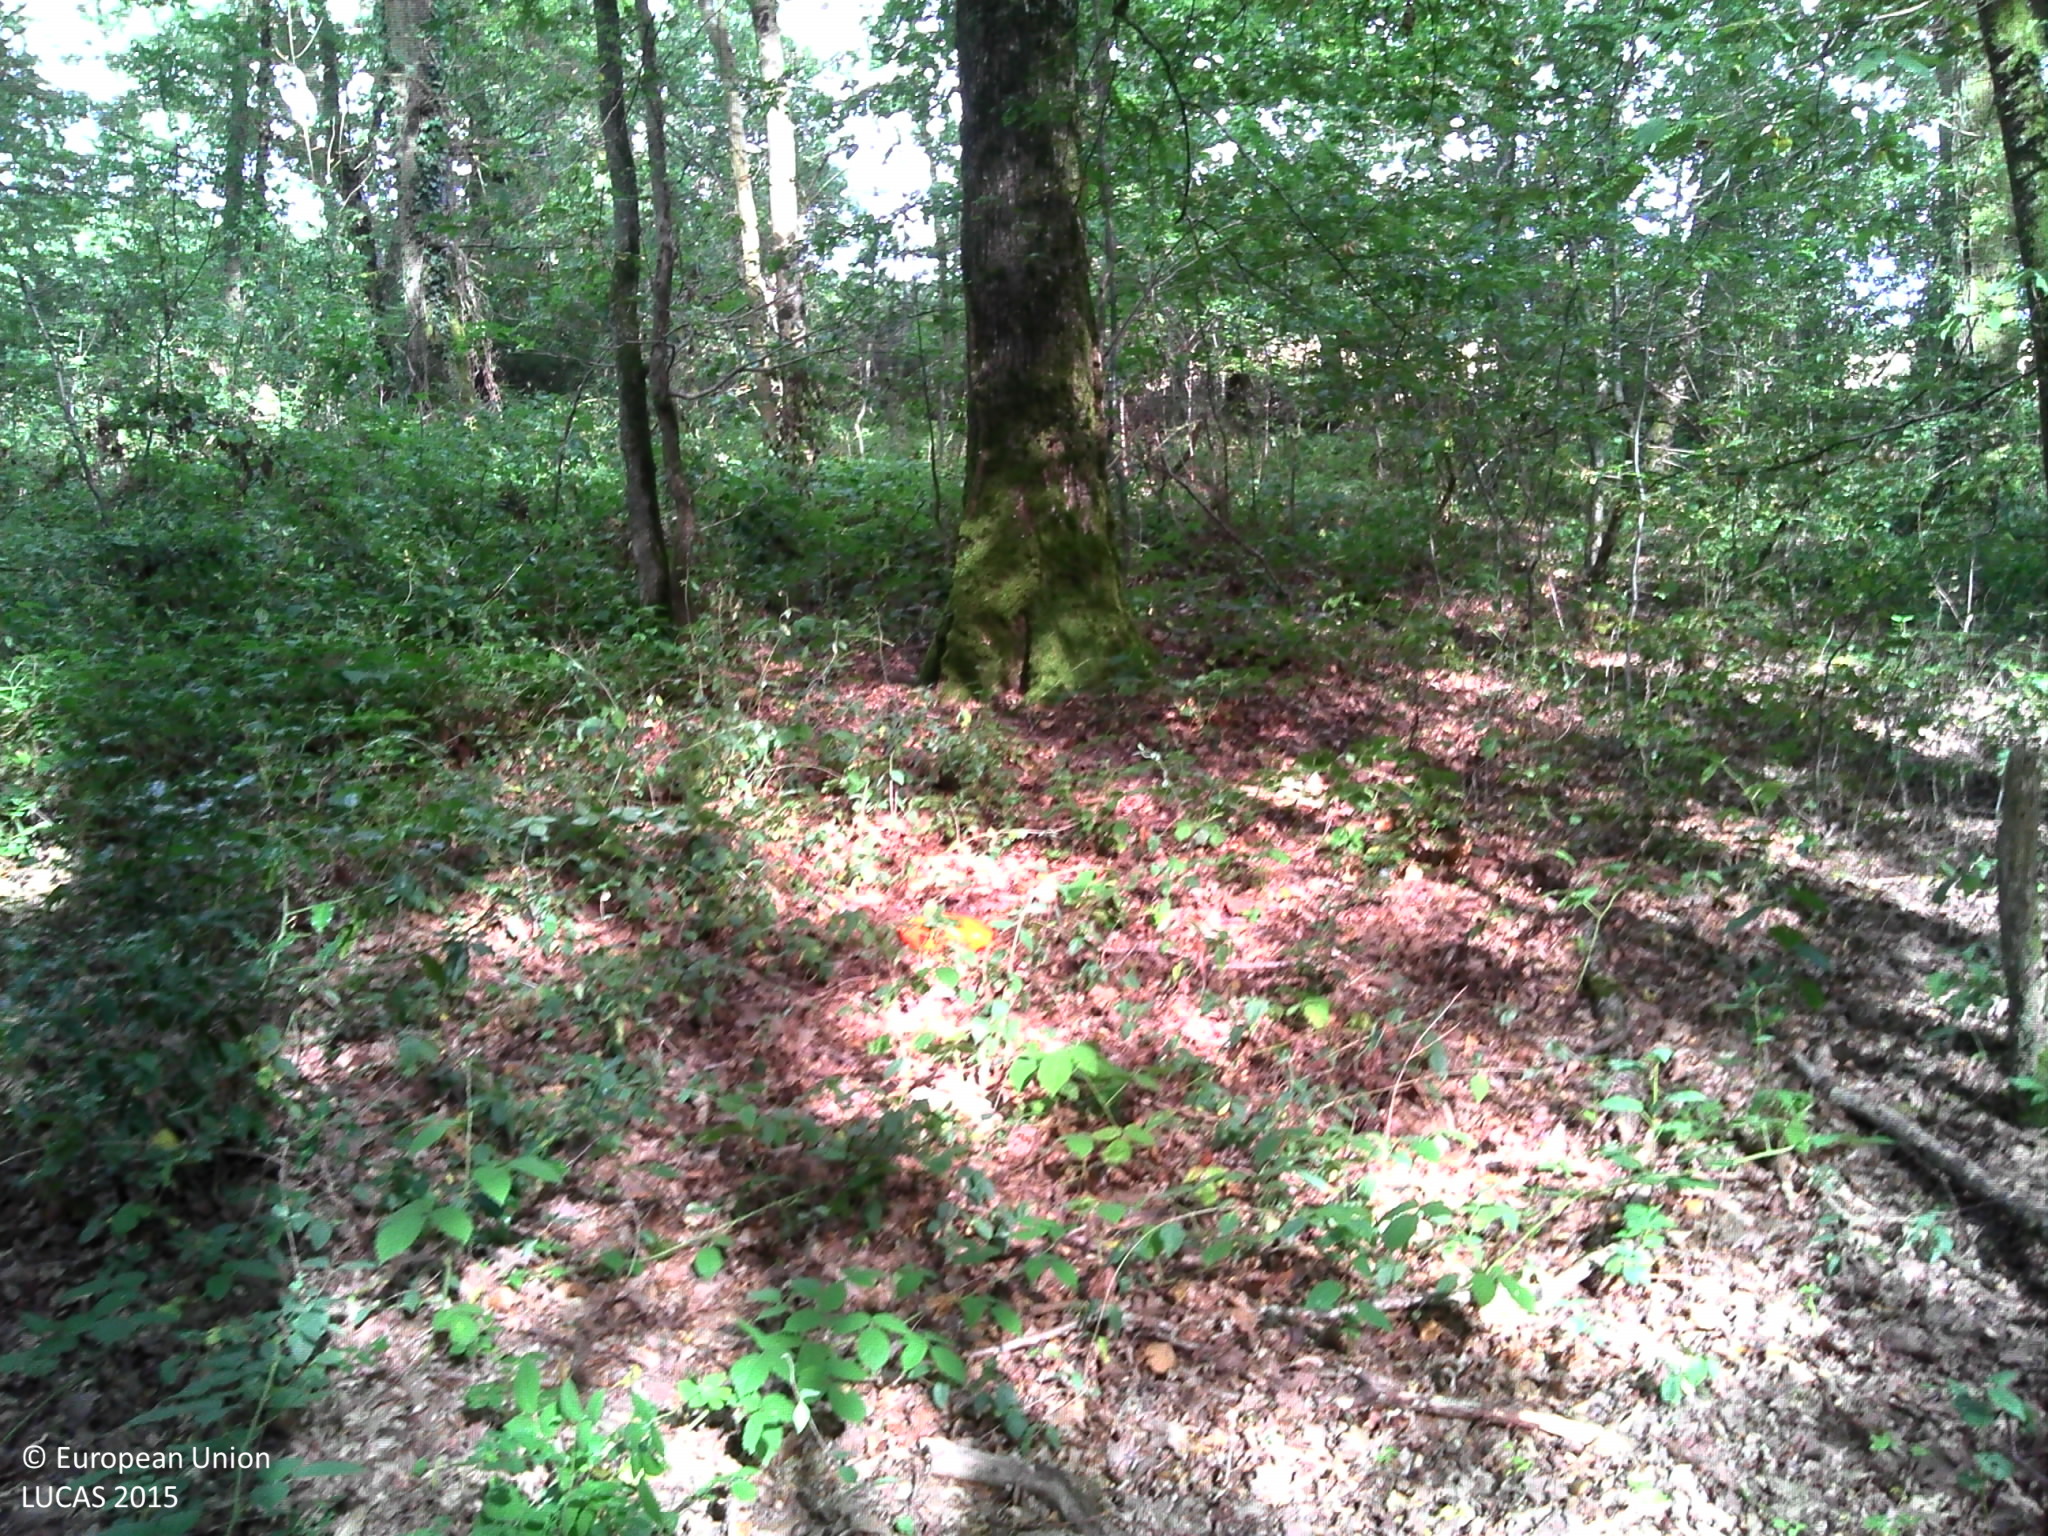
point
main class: Woodland
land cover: Broadleaved woodland
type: mesophytic deciduous forest
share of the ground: > 75 %
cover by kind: broadleaved forest trees 85 %, herbaceous plants 5 %, lichens and mosses 5 %
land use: Forestry
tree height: > 5 m
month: July
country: FR
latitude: 48.1482
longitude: 3.0438
